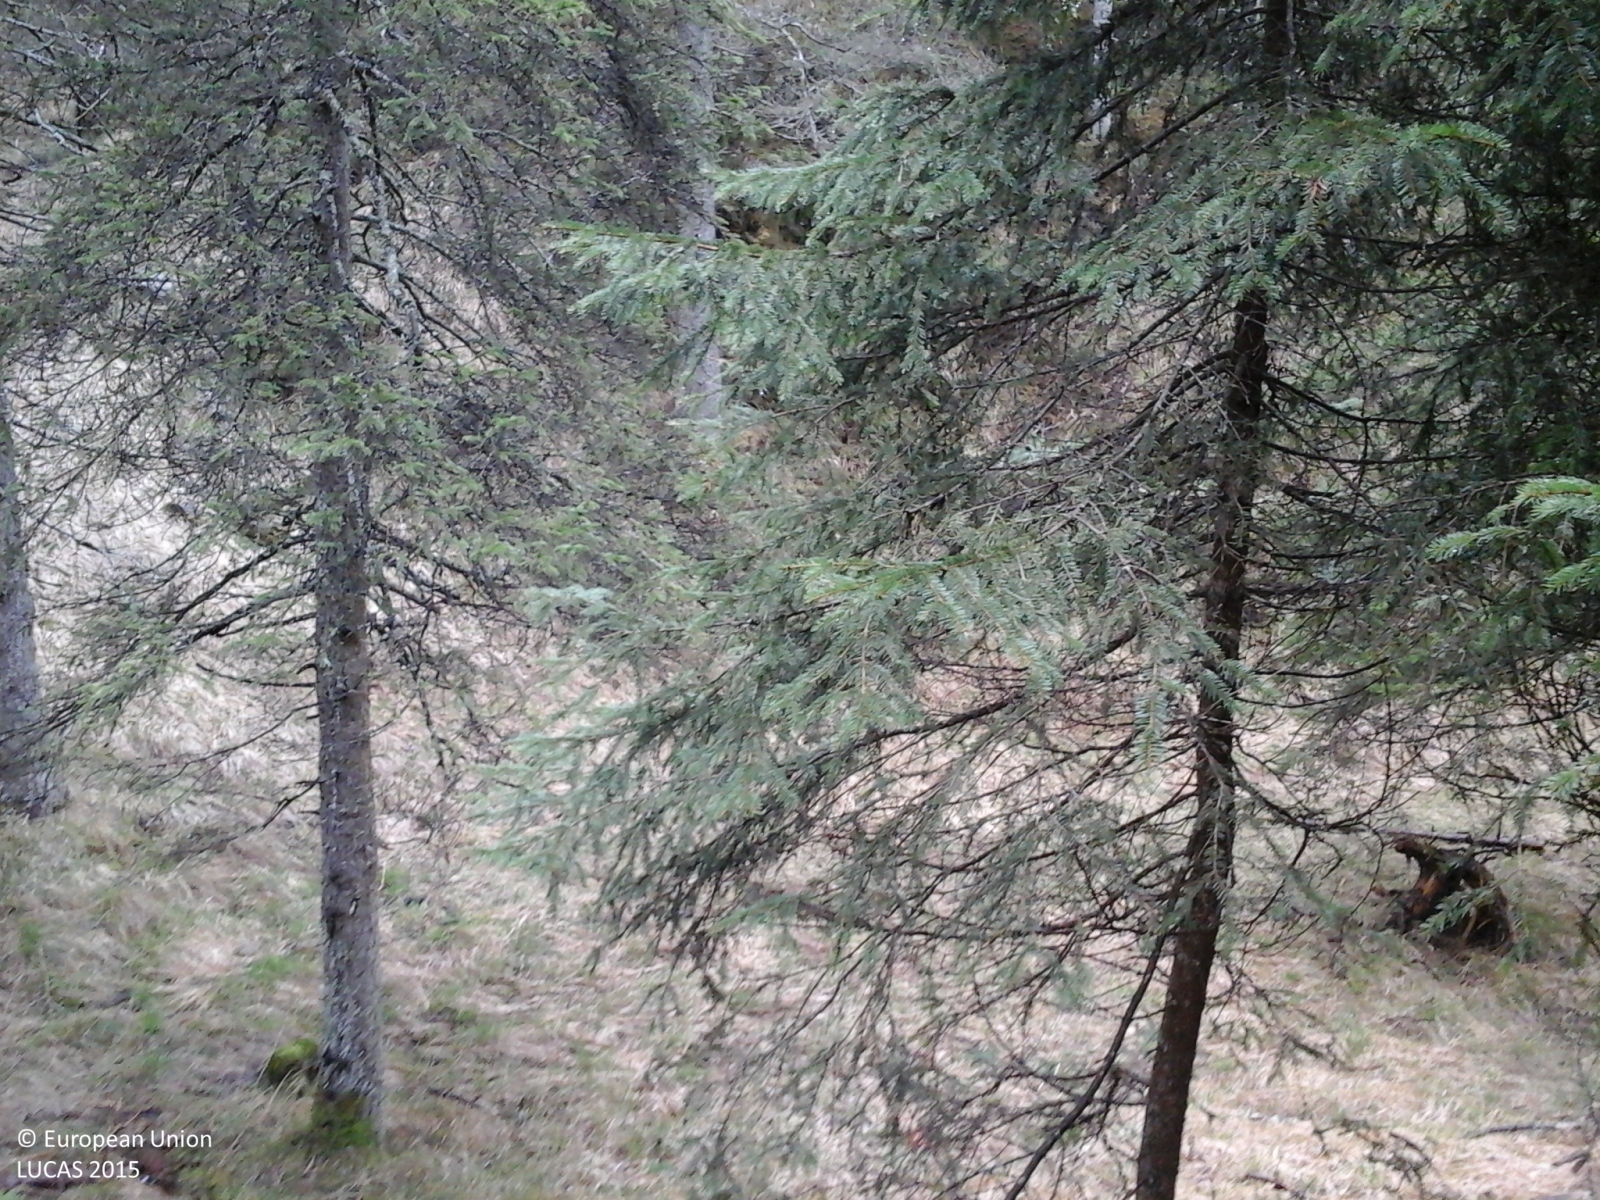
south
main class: Woodland
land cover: Spruce dominated coniferous woodland
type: alpine coniferous forest
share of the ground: > 75 %
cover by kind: coniferous forest trees 100 %
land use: Forestry
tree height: > 5 m
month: May
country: IT
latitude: 46.5073
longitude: 11.1324
